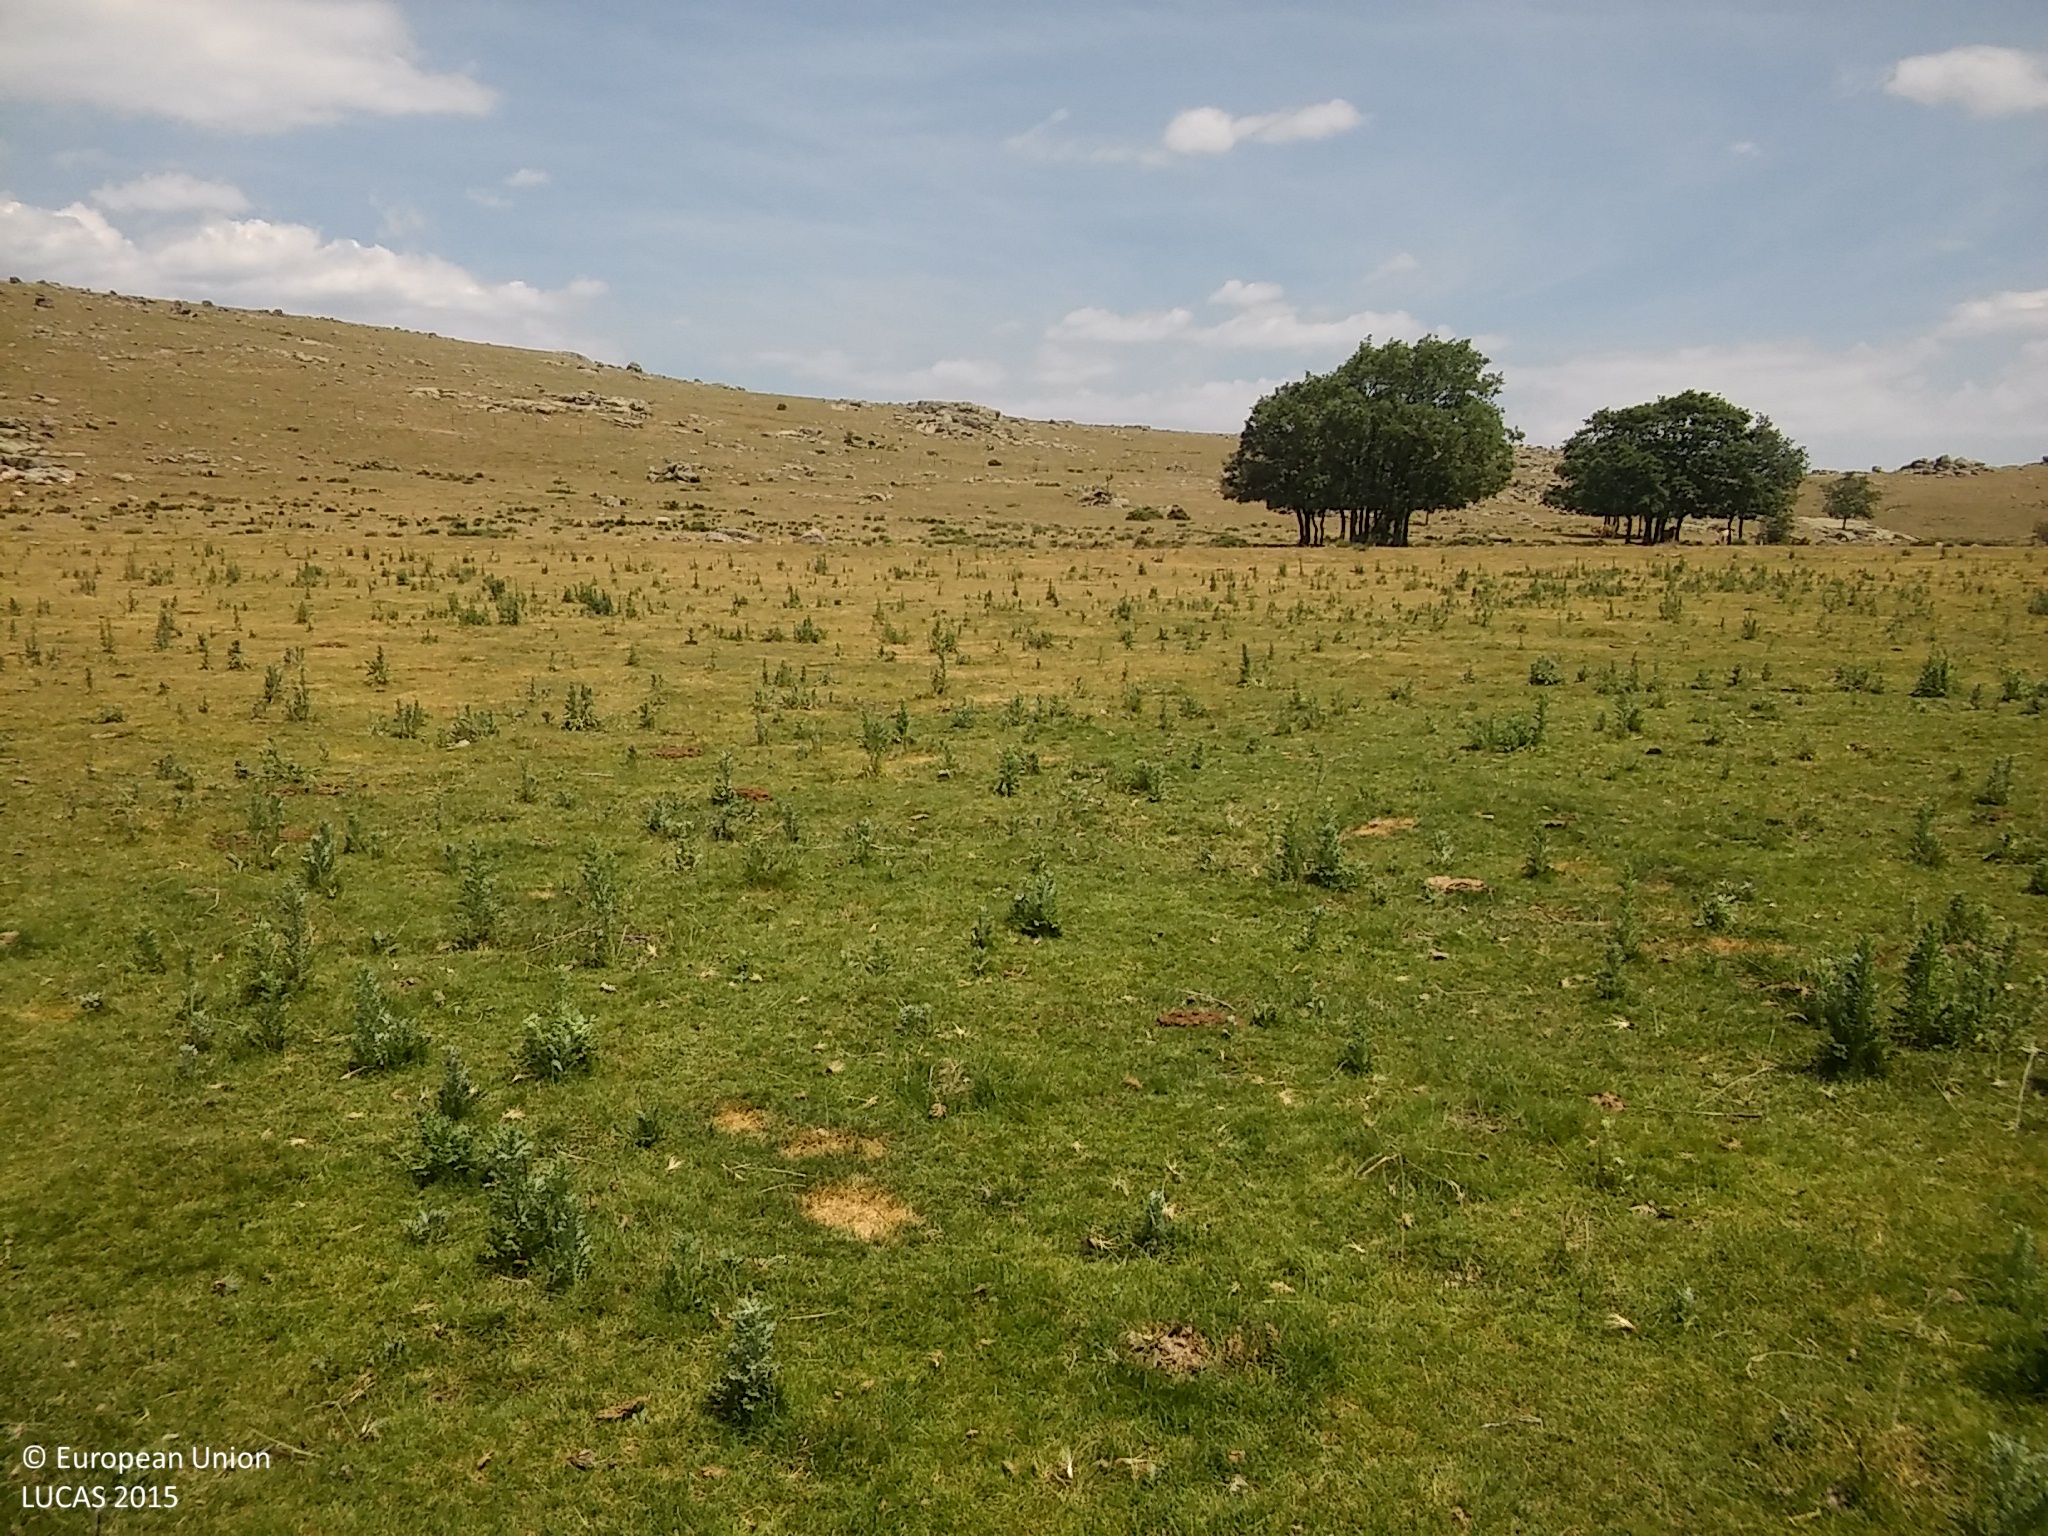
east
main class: Grassland
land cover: Grassland without tree/shrub cover
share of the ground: > 75 %
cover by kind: herbaceous plants 100 %
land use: Agriculture (excluding fallow land and kitchen gardens)
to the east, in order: Grassland without tree/shrub cover; Abandoned hedges; Shrubland with sparse tree cover; Shrubland without tree cover; Rock outcrops; Shrubland without tree cover
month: June
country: ES
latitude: 40.6095
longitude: -4.4104
